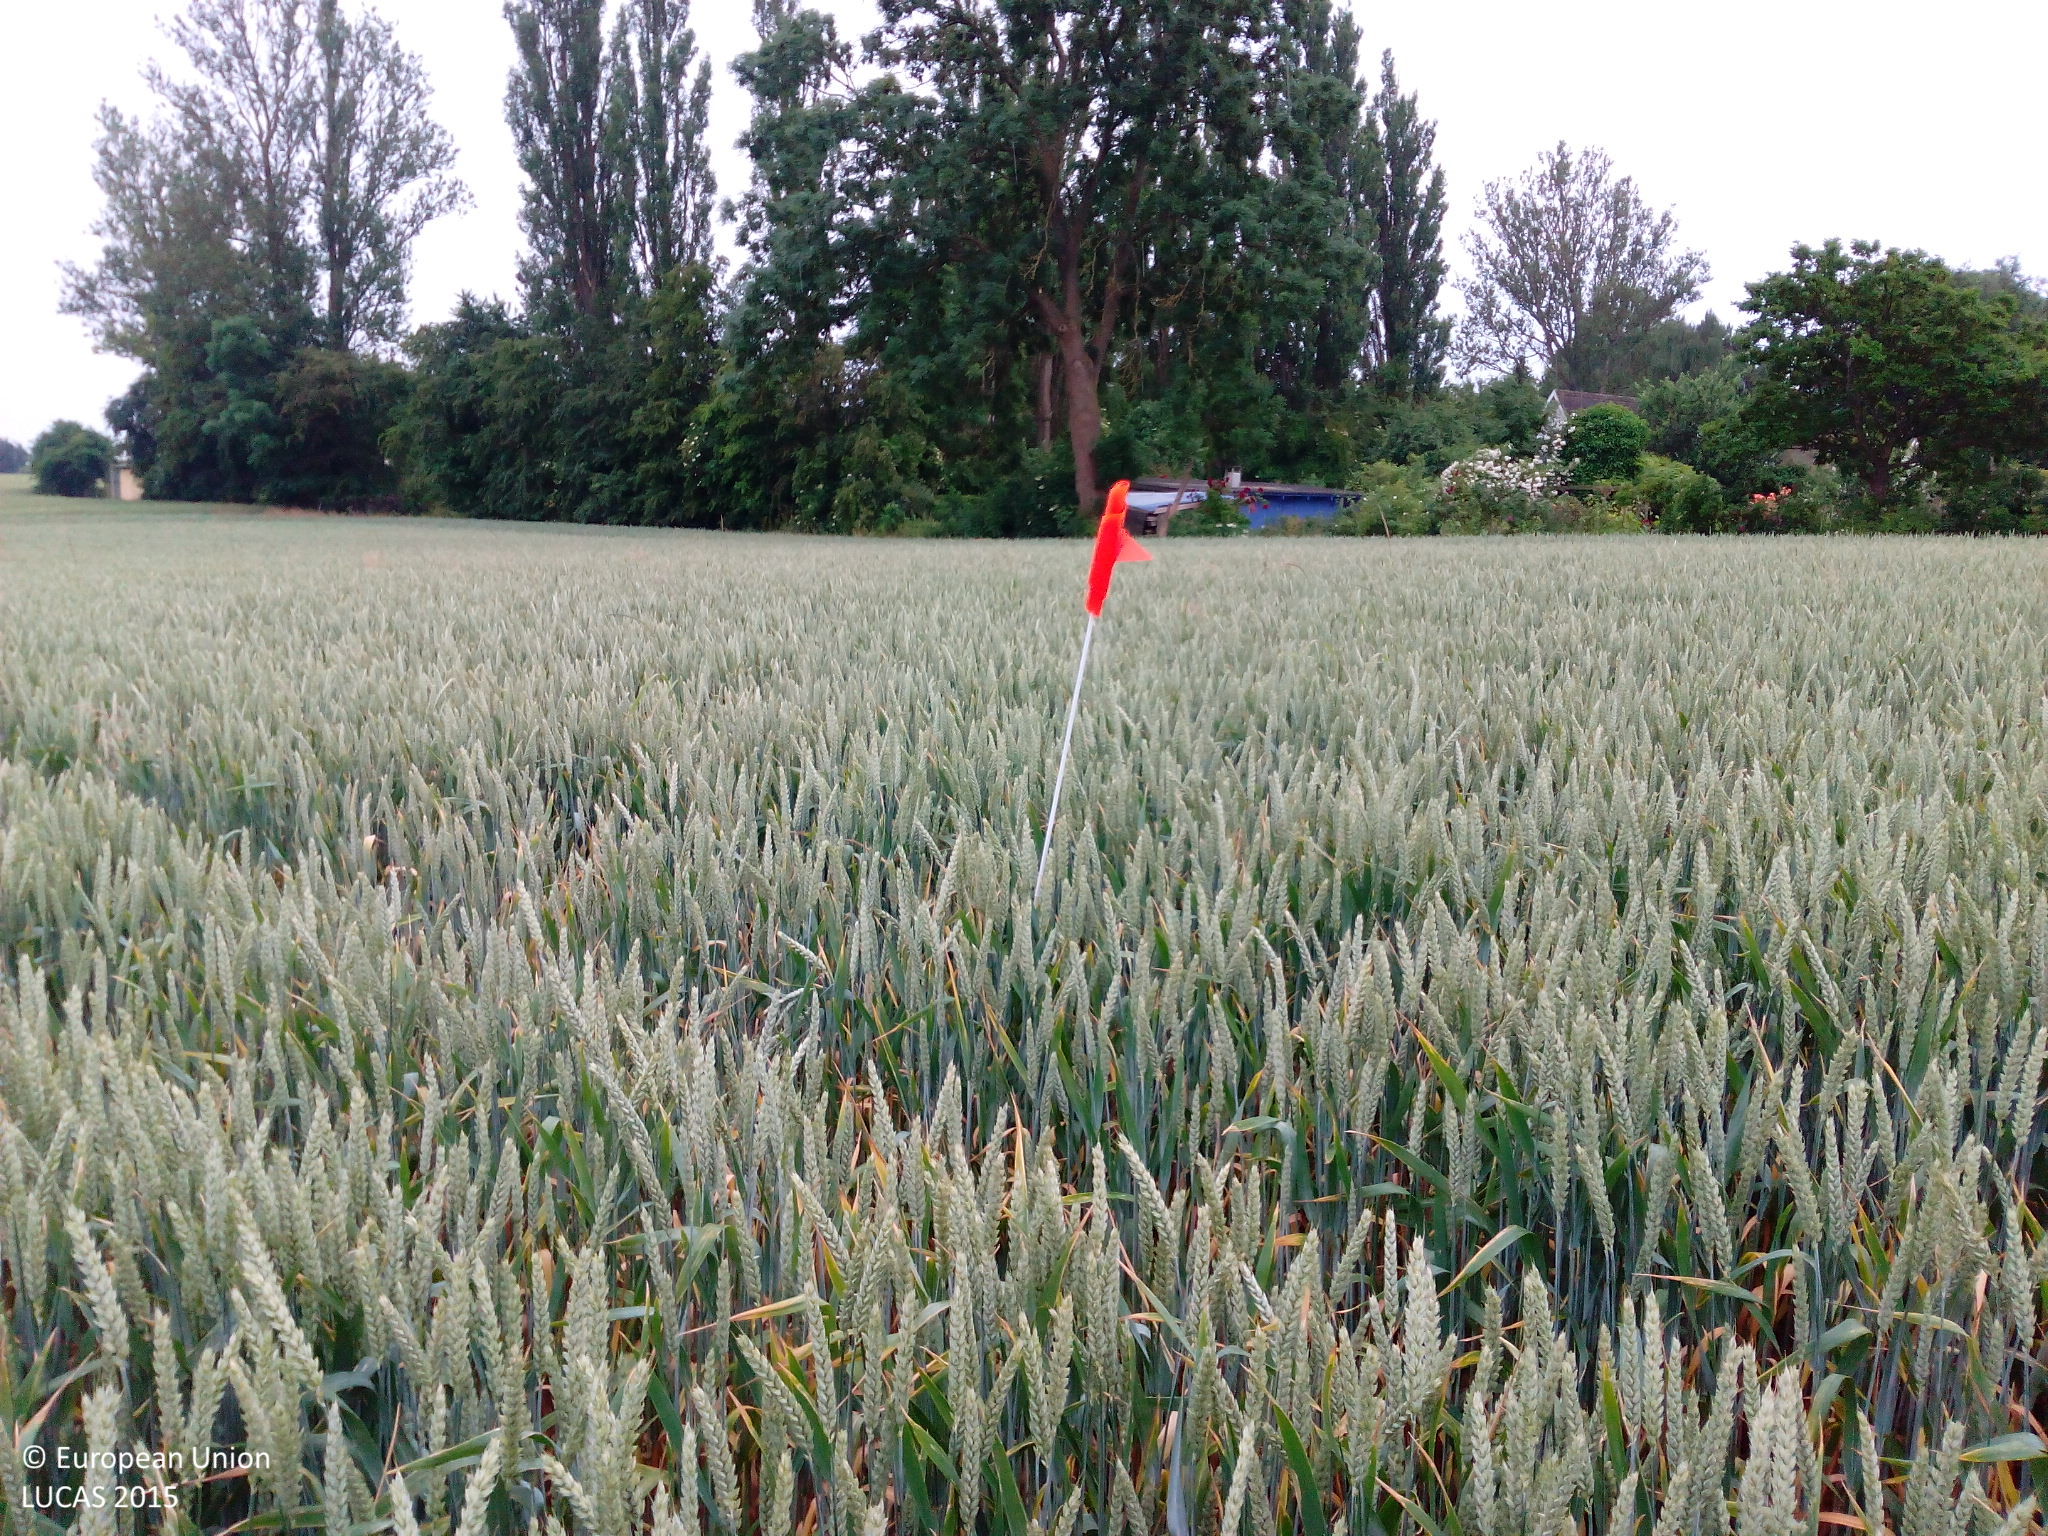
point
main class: Cropland
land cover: Common wheat
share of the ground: > 75 %
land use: Agriculture (excluding fallow land and kitchen gardens)
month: July
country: DK
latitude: 55.2255
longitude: 11.5552
